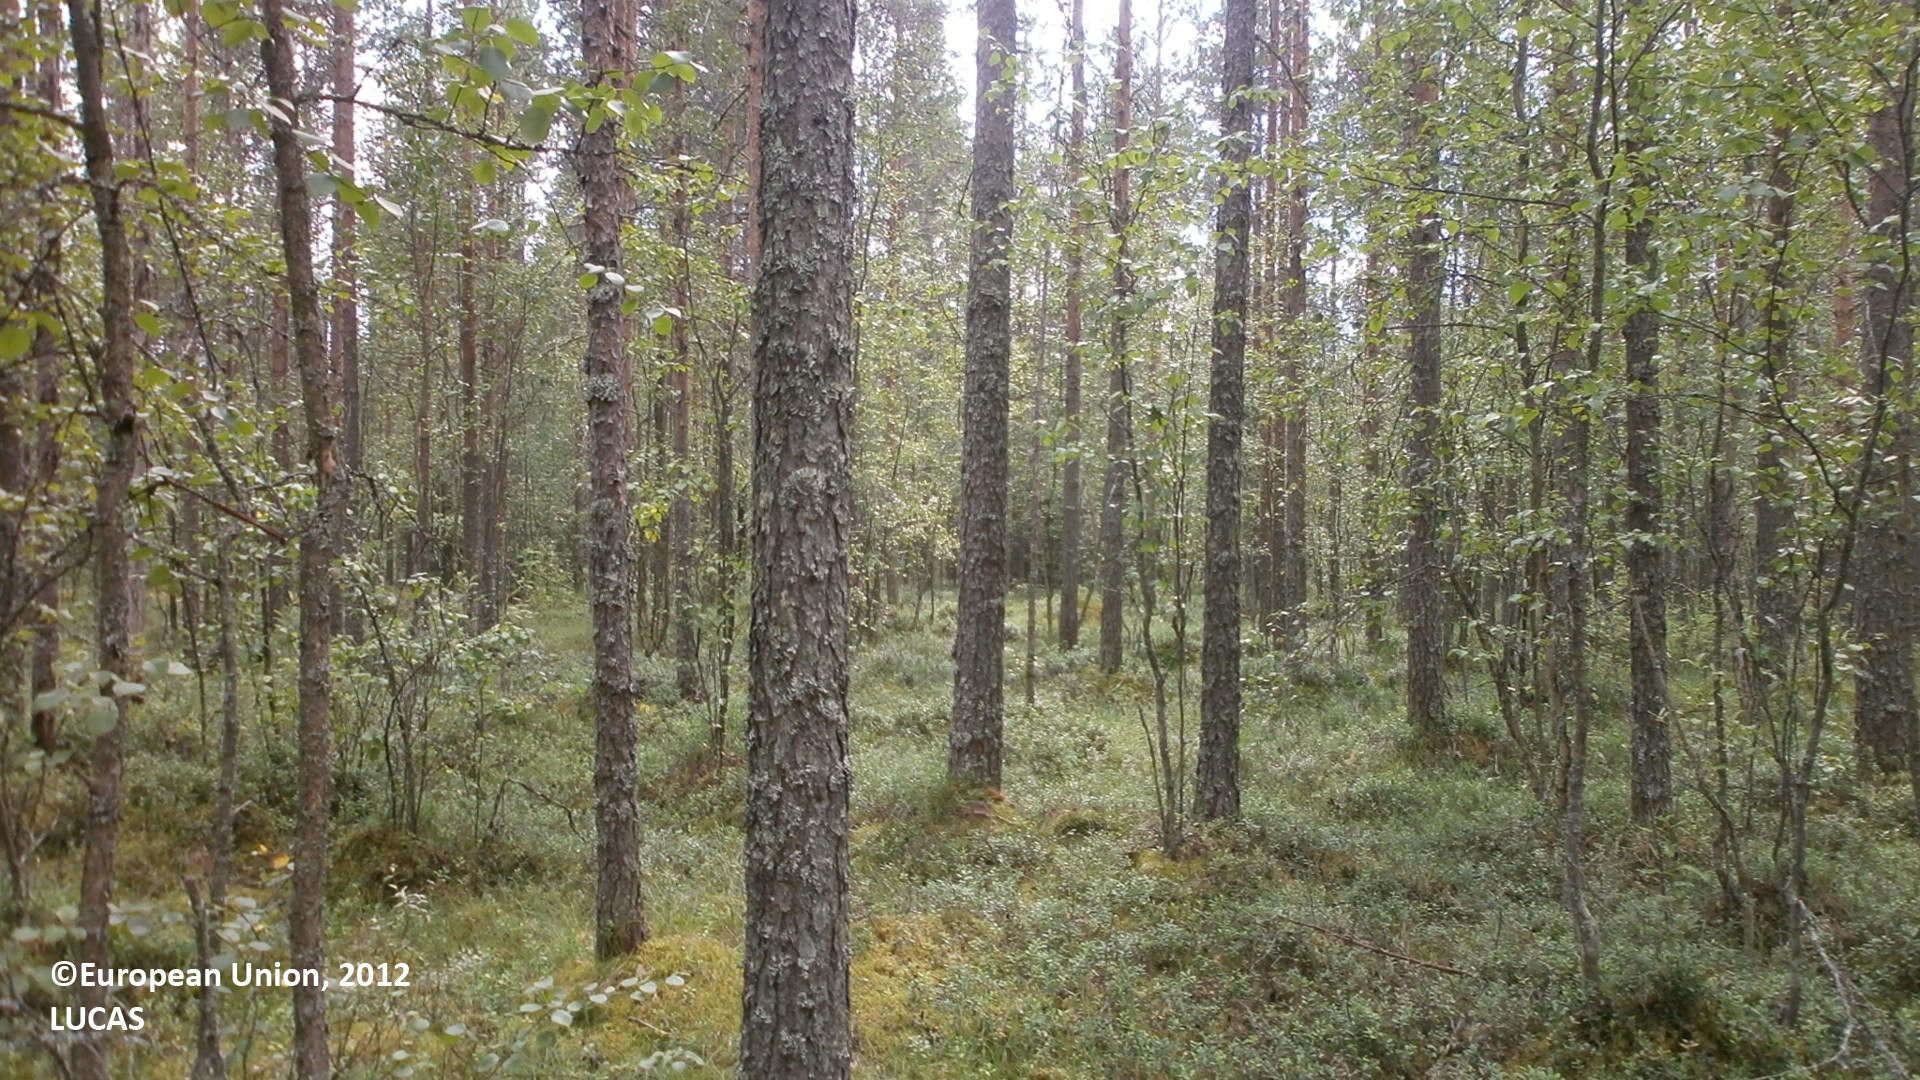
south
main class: Woodland
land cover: Pine dominated coniferous woodland
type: boreal forest
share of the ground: 50 - 75 %
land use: Forestry
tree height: > 5 m
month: July
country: FI
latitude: 64.1678
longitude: 24.9114
